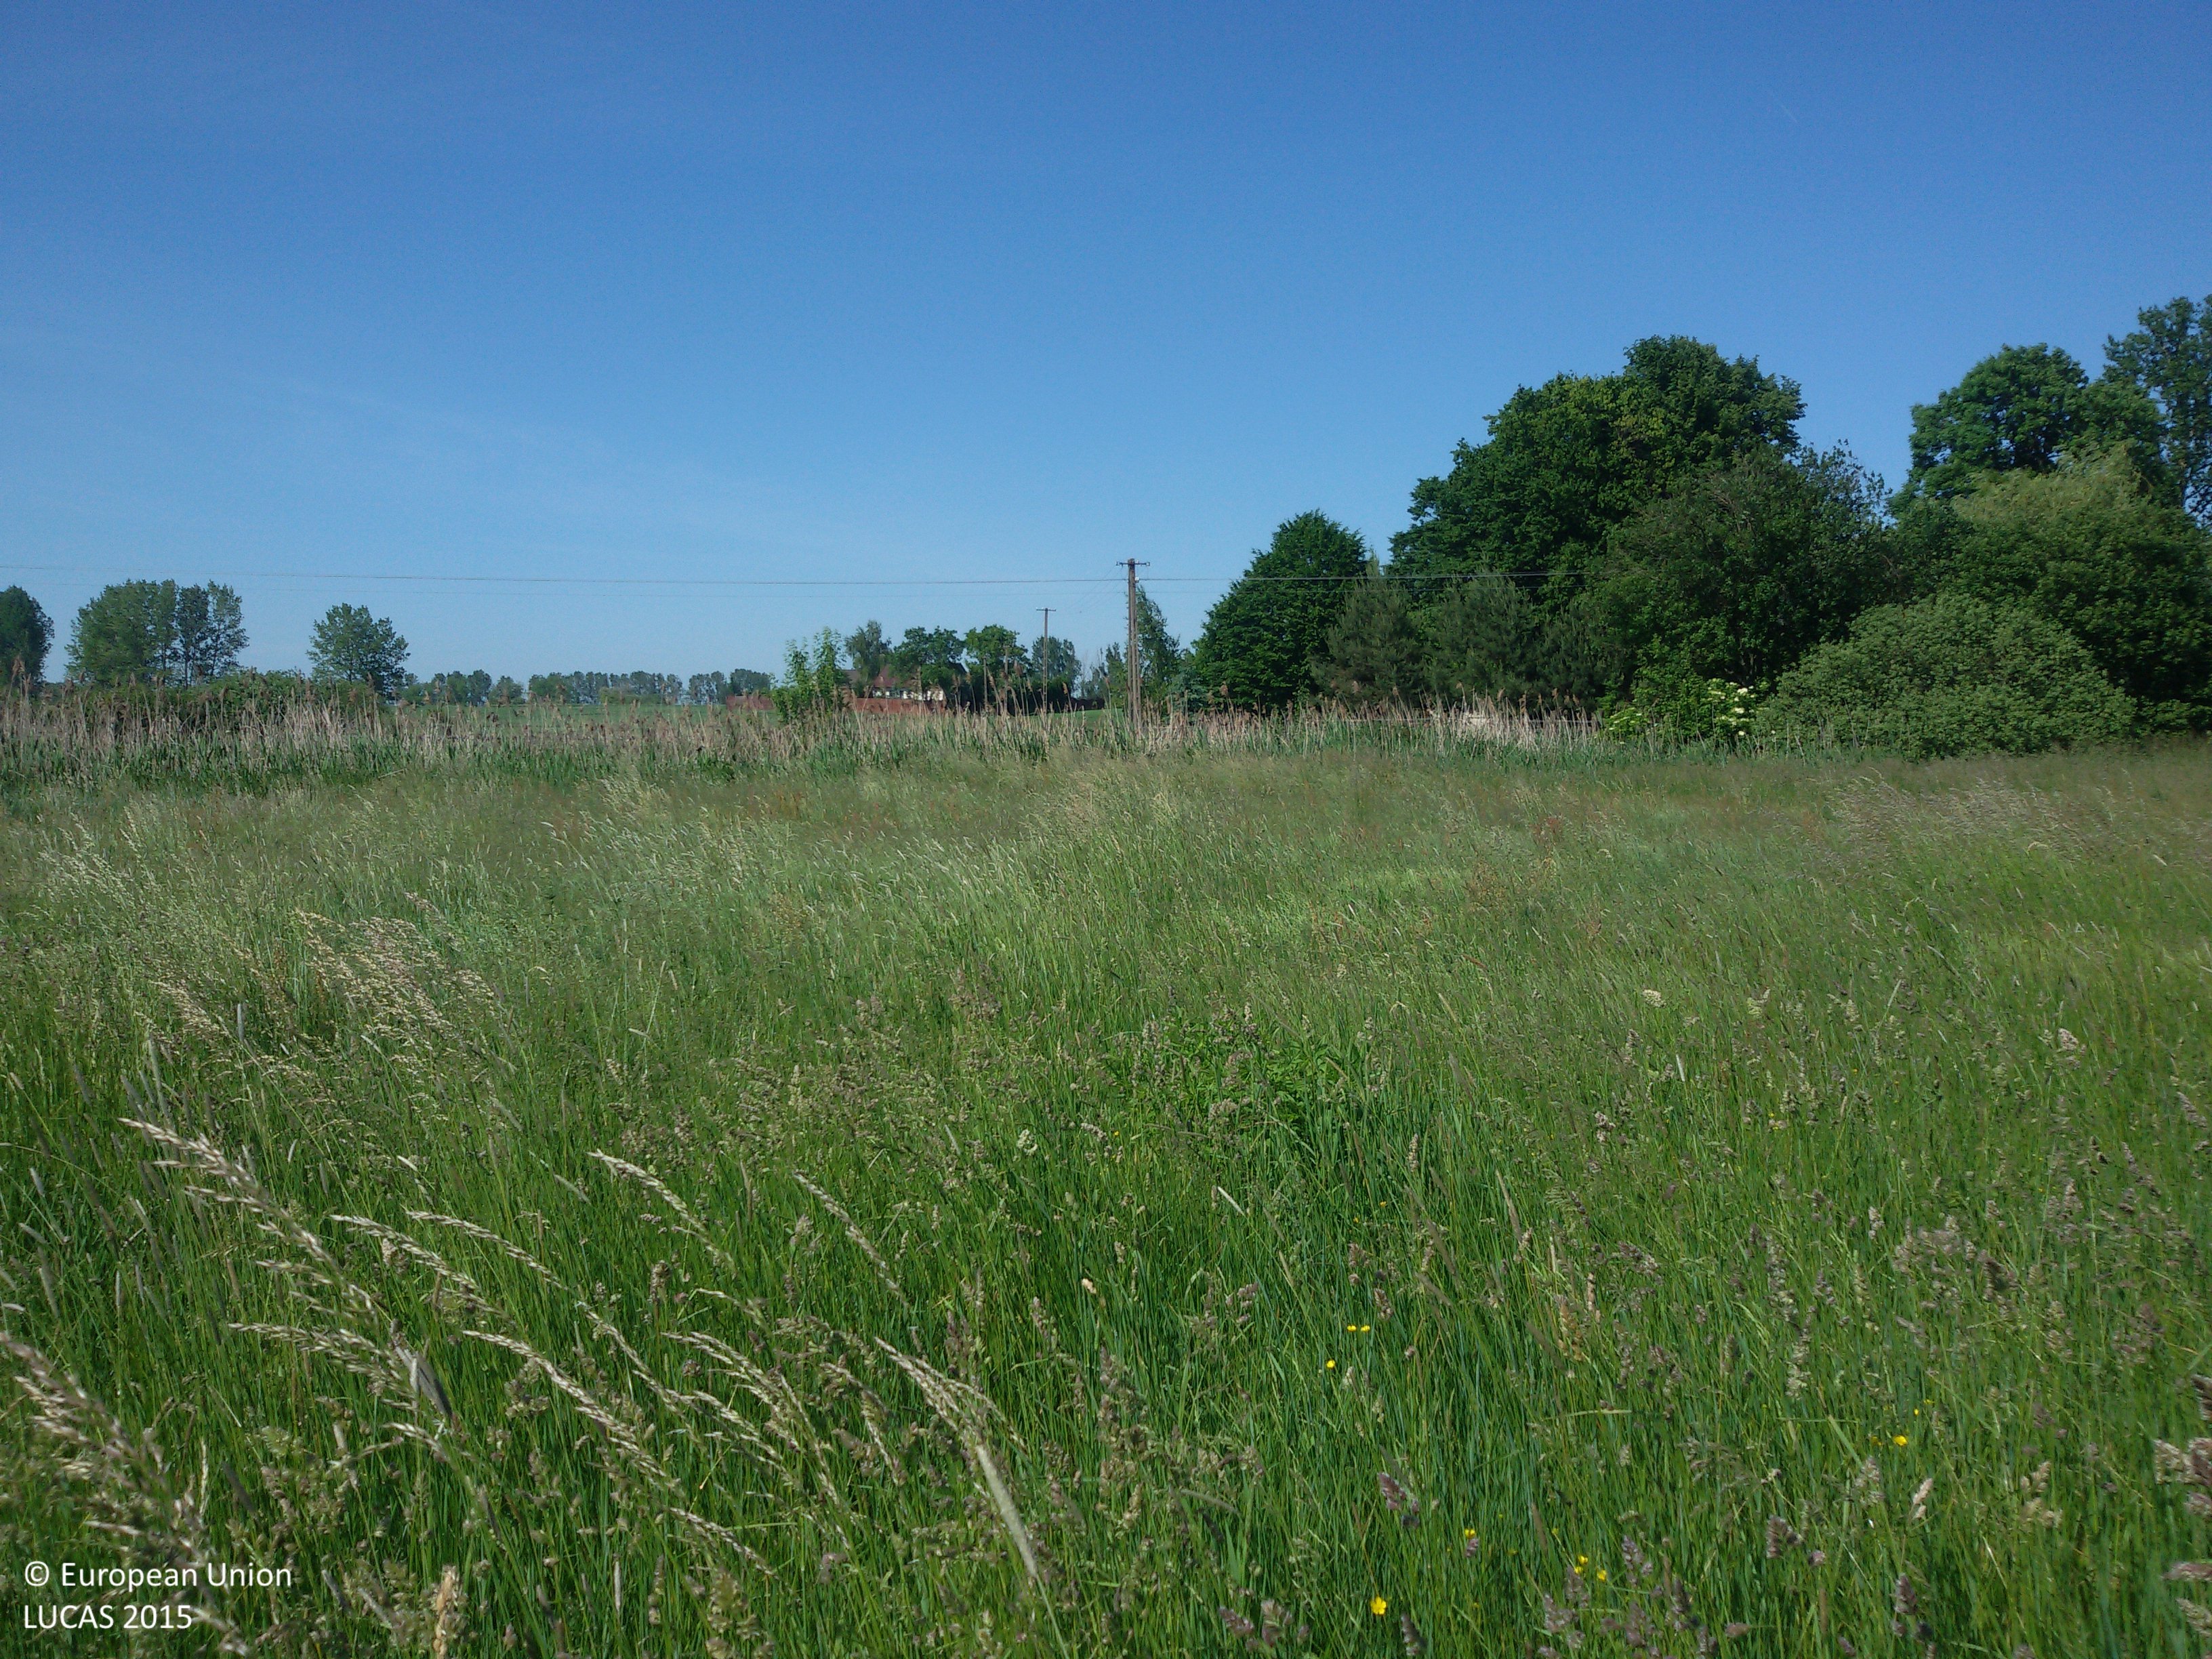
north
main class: Grassland
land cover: Grassland without tree/shrub cover
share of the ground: > 75 %
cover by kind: herbaceous plants 100 %
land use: Semi-natural and natural areas not in use
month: June
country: PL
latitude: 51.2160
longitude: 22.8862
